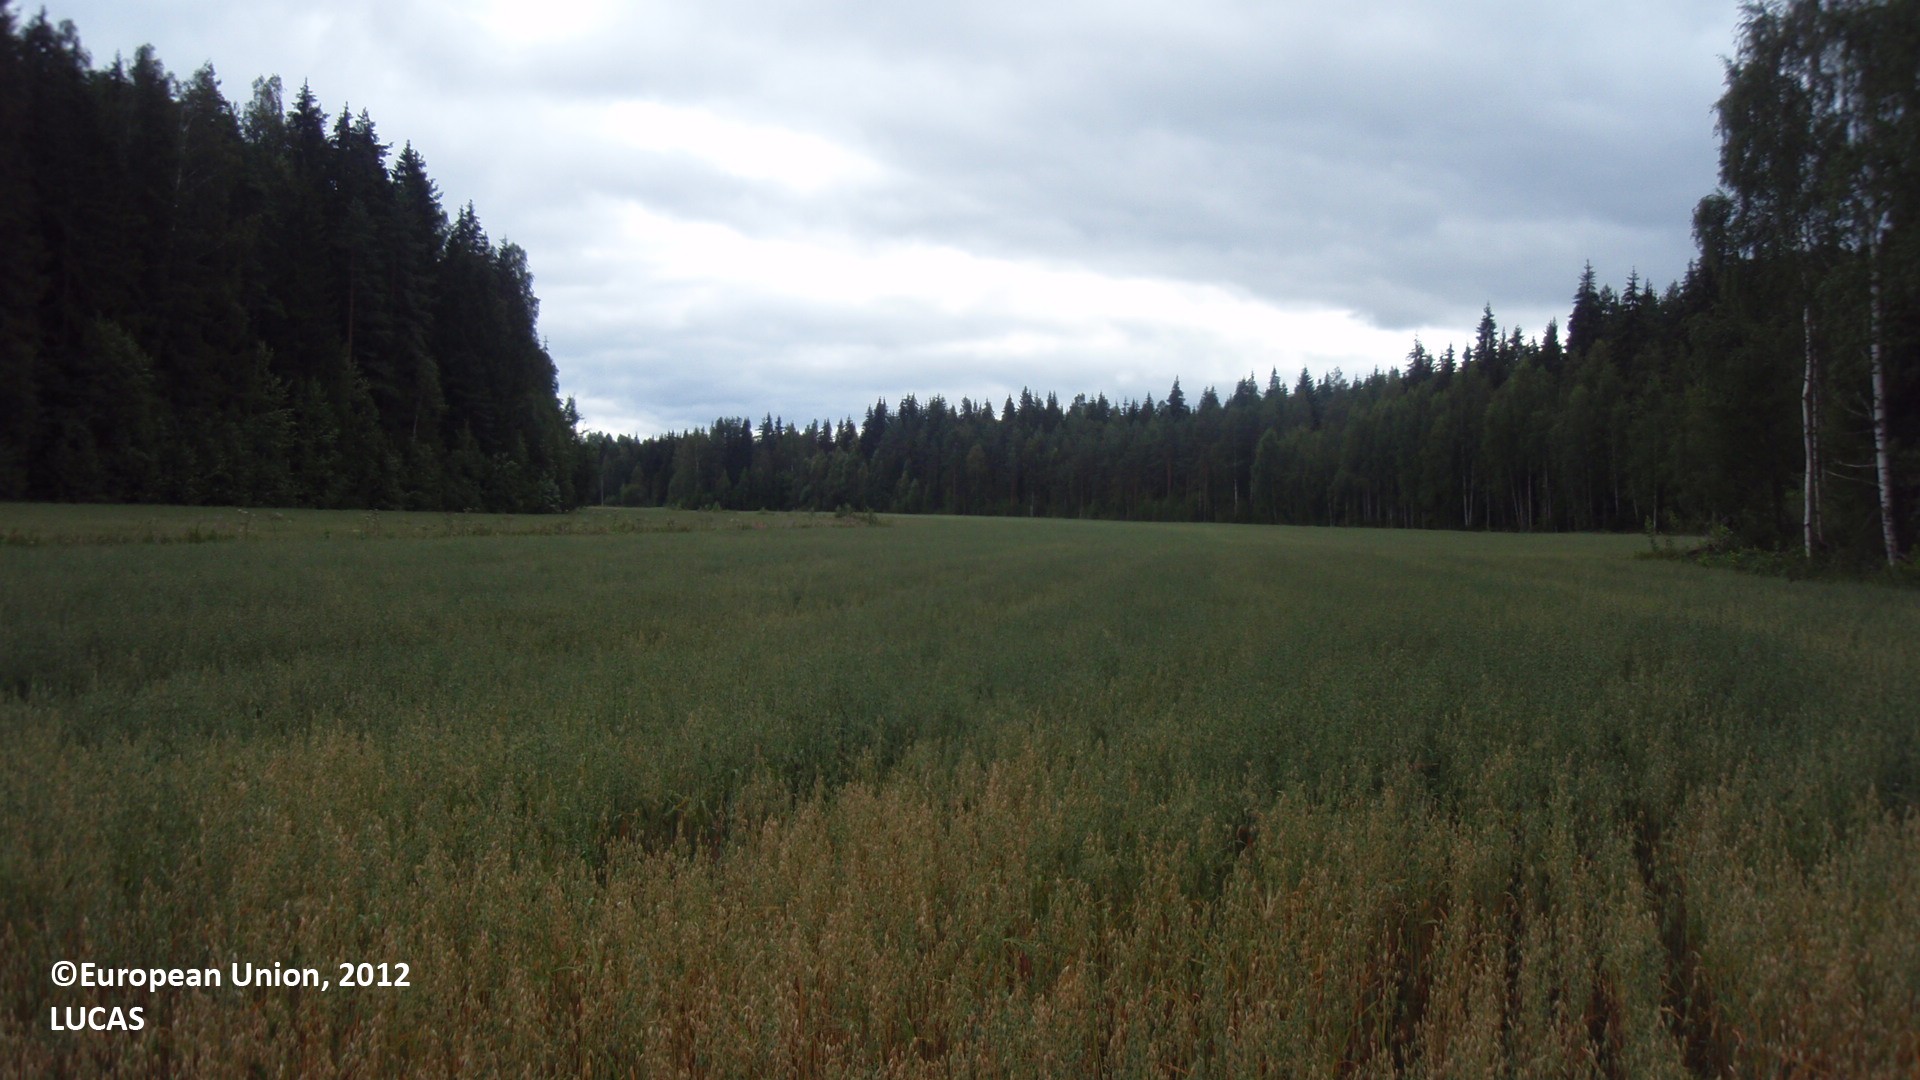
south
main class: Cropland
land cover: Oats
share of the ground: > 75 %
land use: Agriculture (excluding fallow land and kitchen gardens)
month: August
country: FI
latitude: 60.9938
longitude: 27.5432
